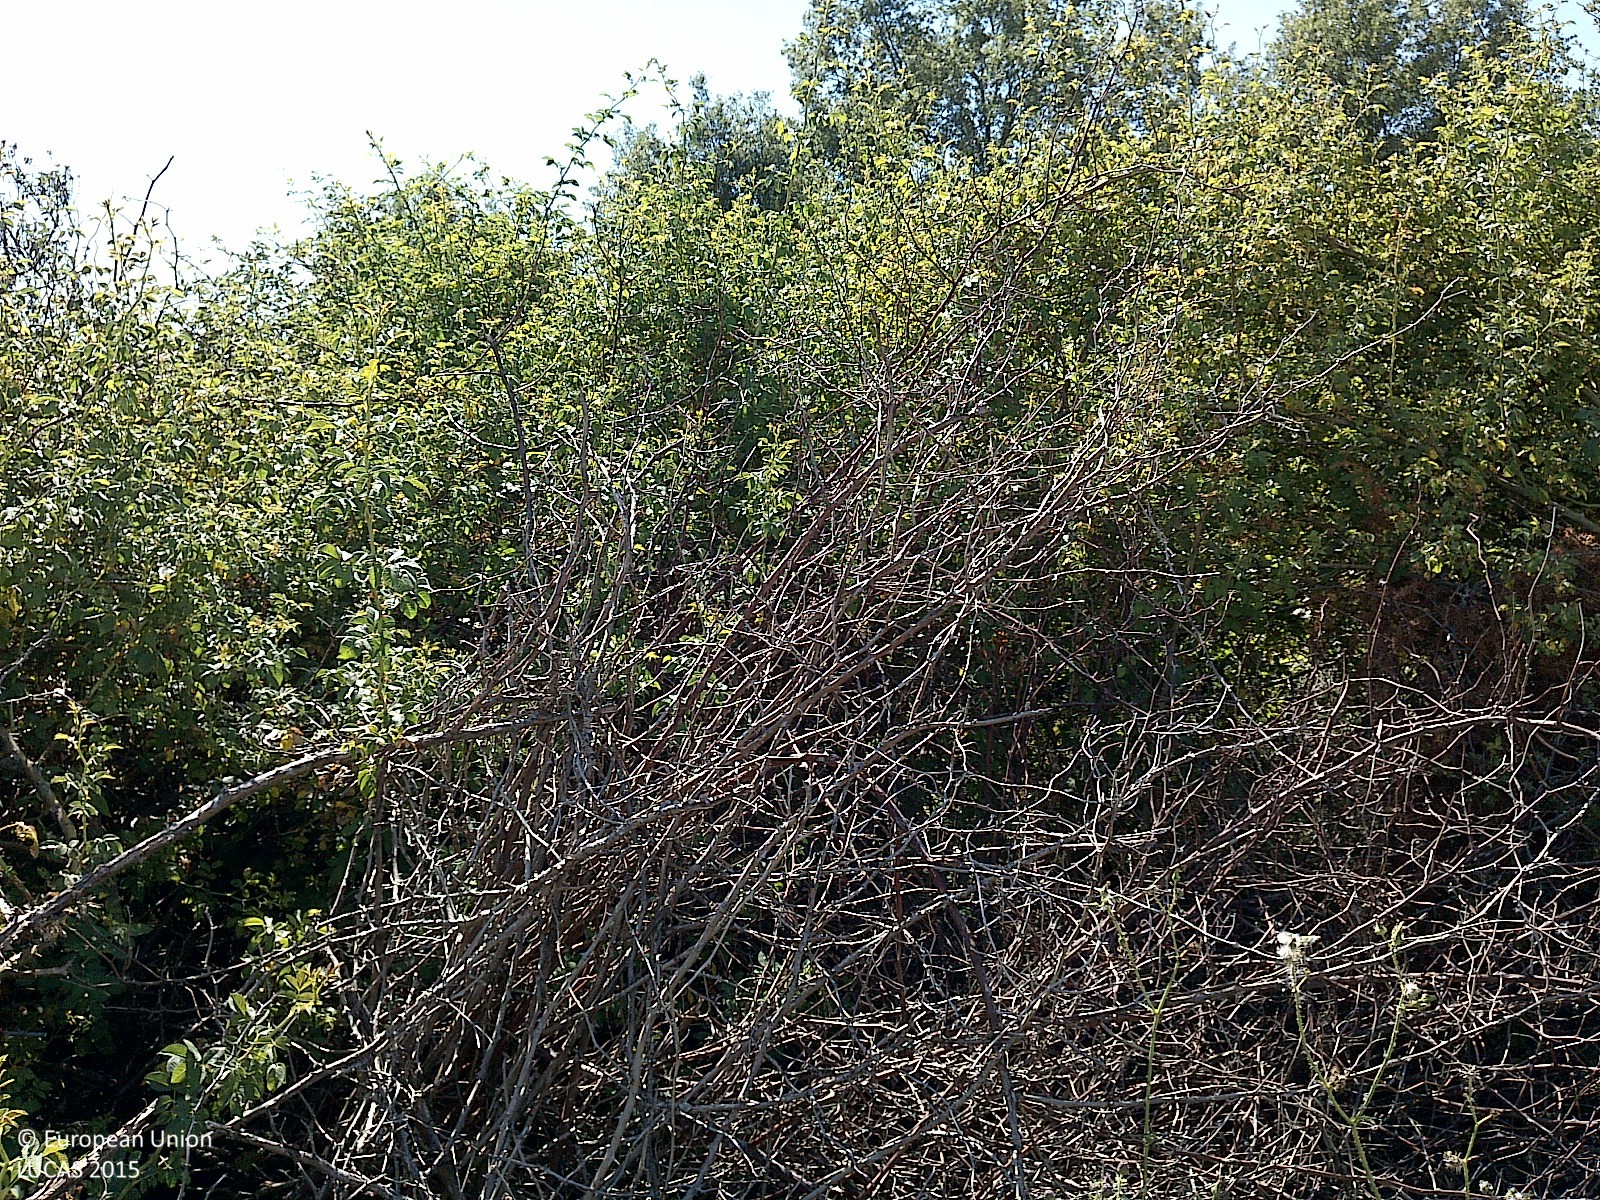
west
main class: Shrubland
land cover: Shrubland with sparse tree cover
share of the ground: > 75 %
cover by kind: shrubs 80 %, herbaceous plants 15 %, broadleaved forest trees 5 %
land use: Semi-natural and natural areas not in use
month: July
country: ES
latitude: 41.6763
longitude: -3.1993
